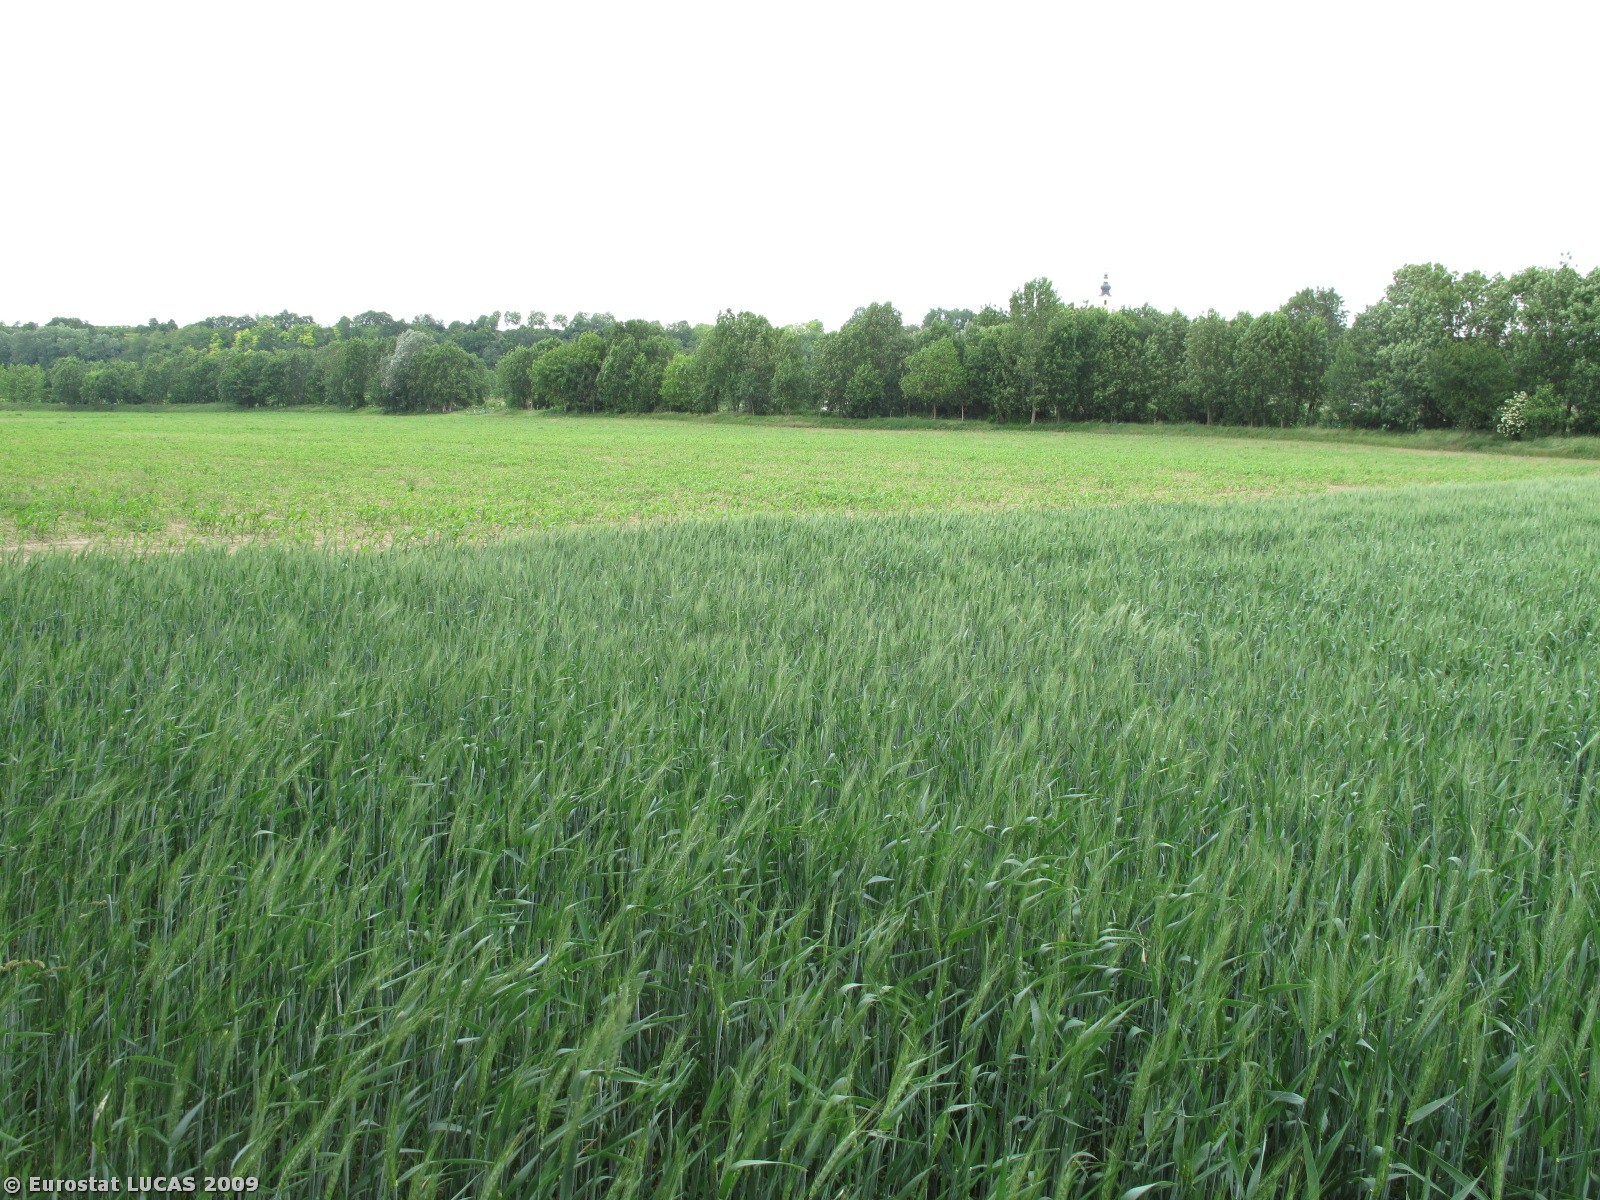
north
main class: Cropland
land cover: Common wheat
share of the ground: > 75 %
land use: Agriculture (excluding fallow land and kitchen gardens)
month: May
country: AT
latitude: 48.4021
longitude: 16.0151
